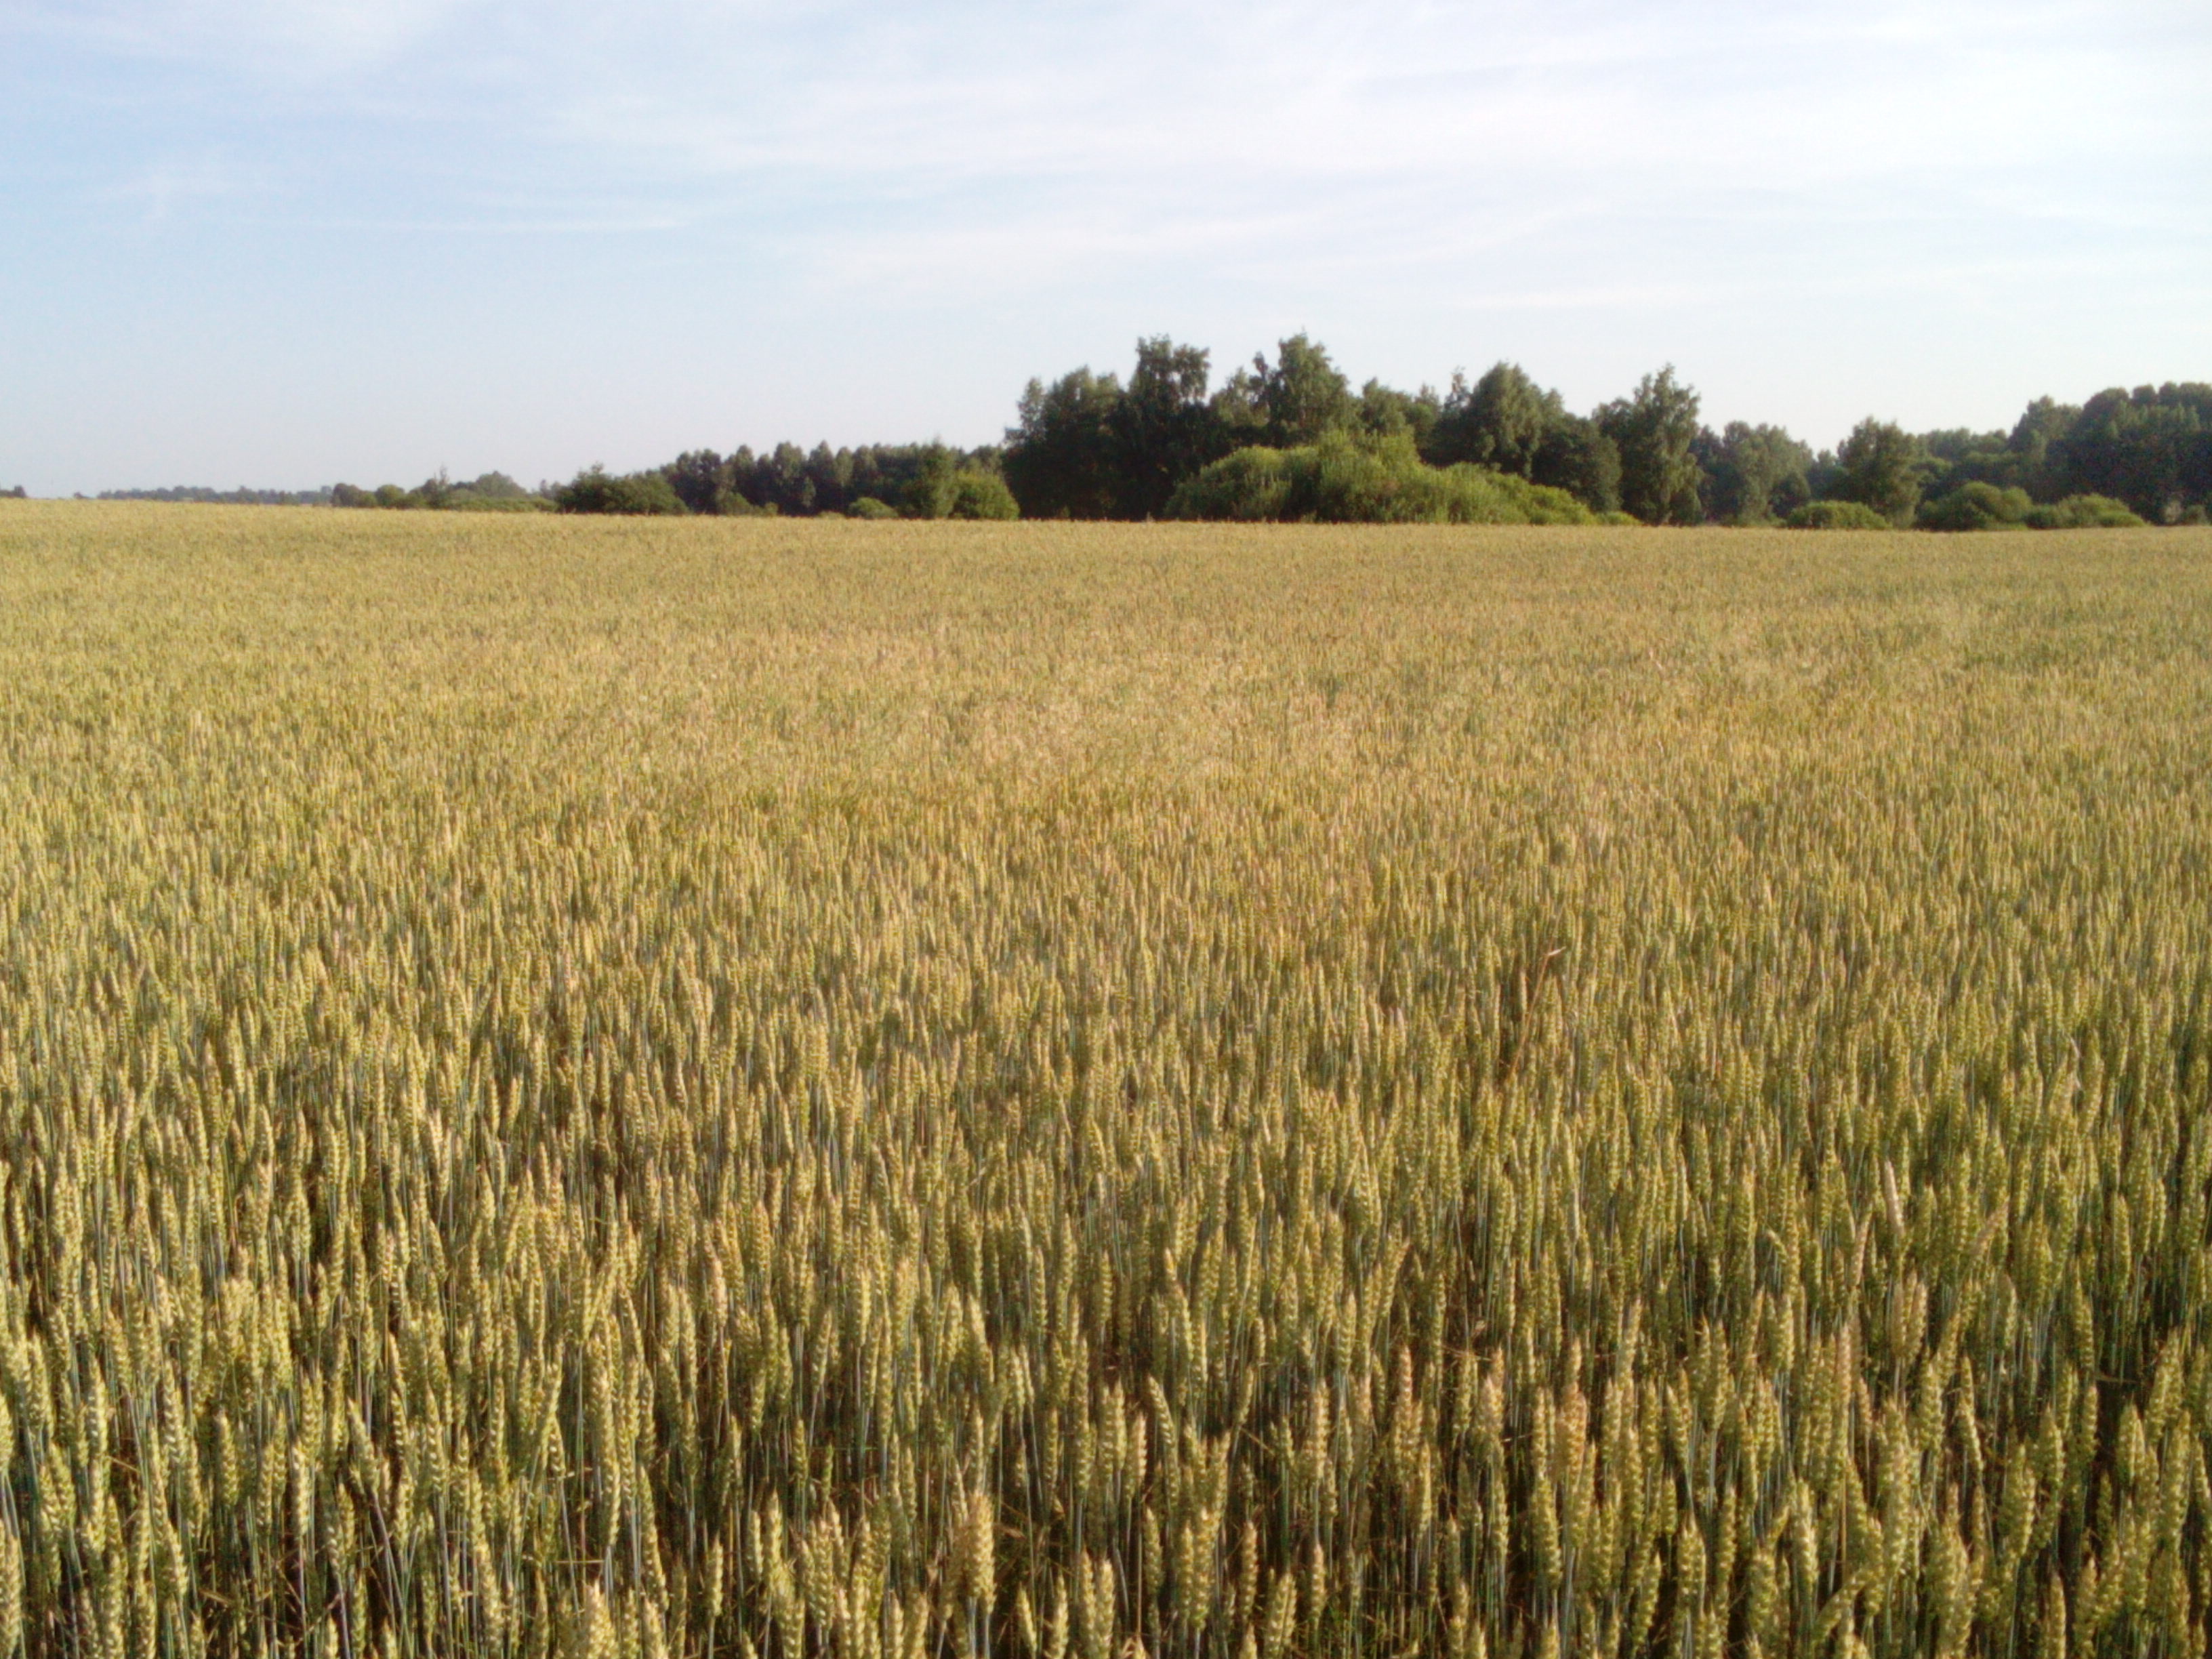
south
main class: Cropland
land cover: Common wheat
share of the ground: > 75 %
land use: Agriculture (excluding fallow land and kitchen gardens)
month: August
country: LV
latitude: 56.8656
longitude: 21.7399
